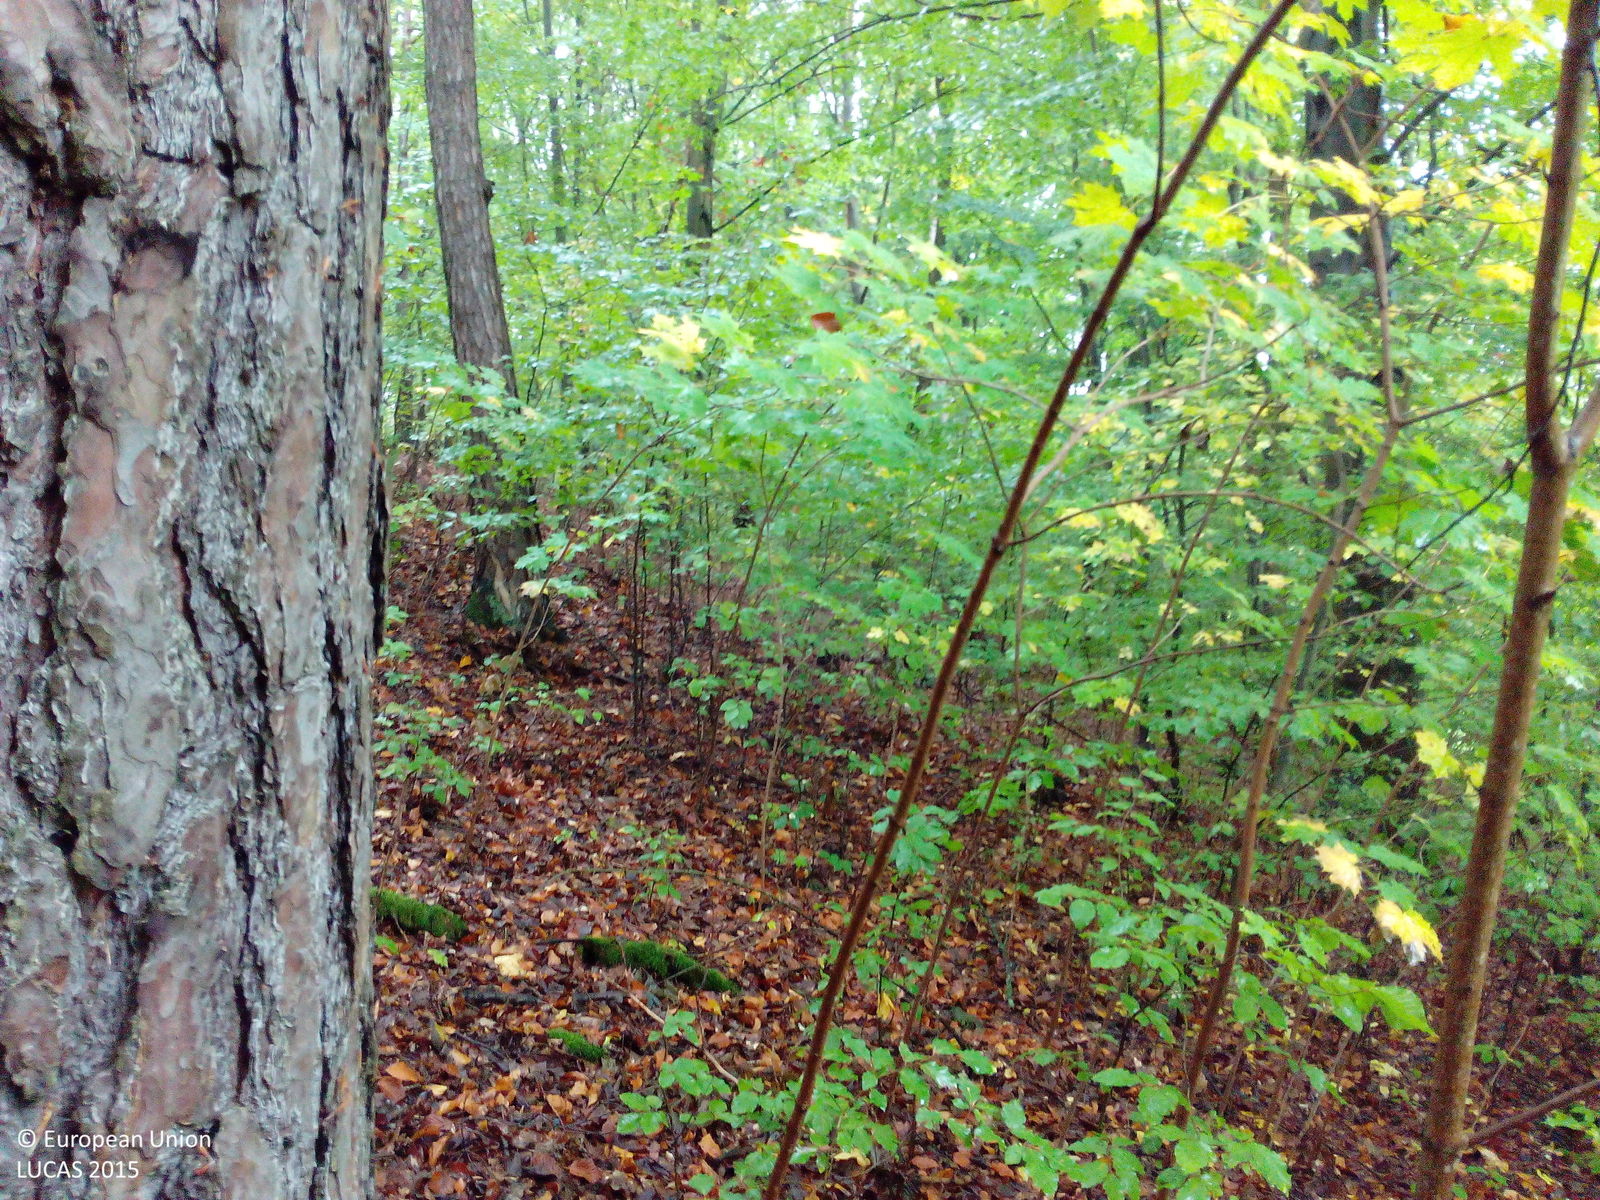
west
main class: Woodland
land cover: Broadleaved woodland
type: beech forest
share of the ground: 50 - 75 %
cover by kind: broadleaved forest trees 70 %, unconsolidated bare surface 15 %, shrubs 10 %, herbaceous plants 5 %
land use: Forestry
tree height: > 5 m
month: October
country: DE
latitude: 50.0943
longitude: 9.9022
